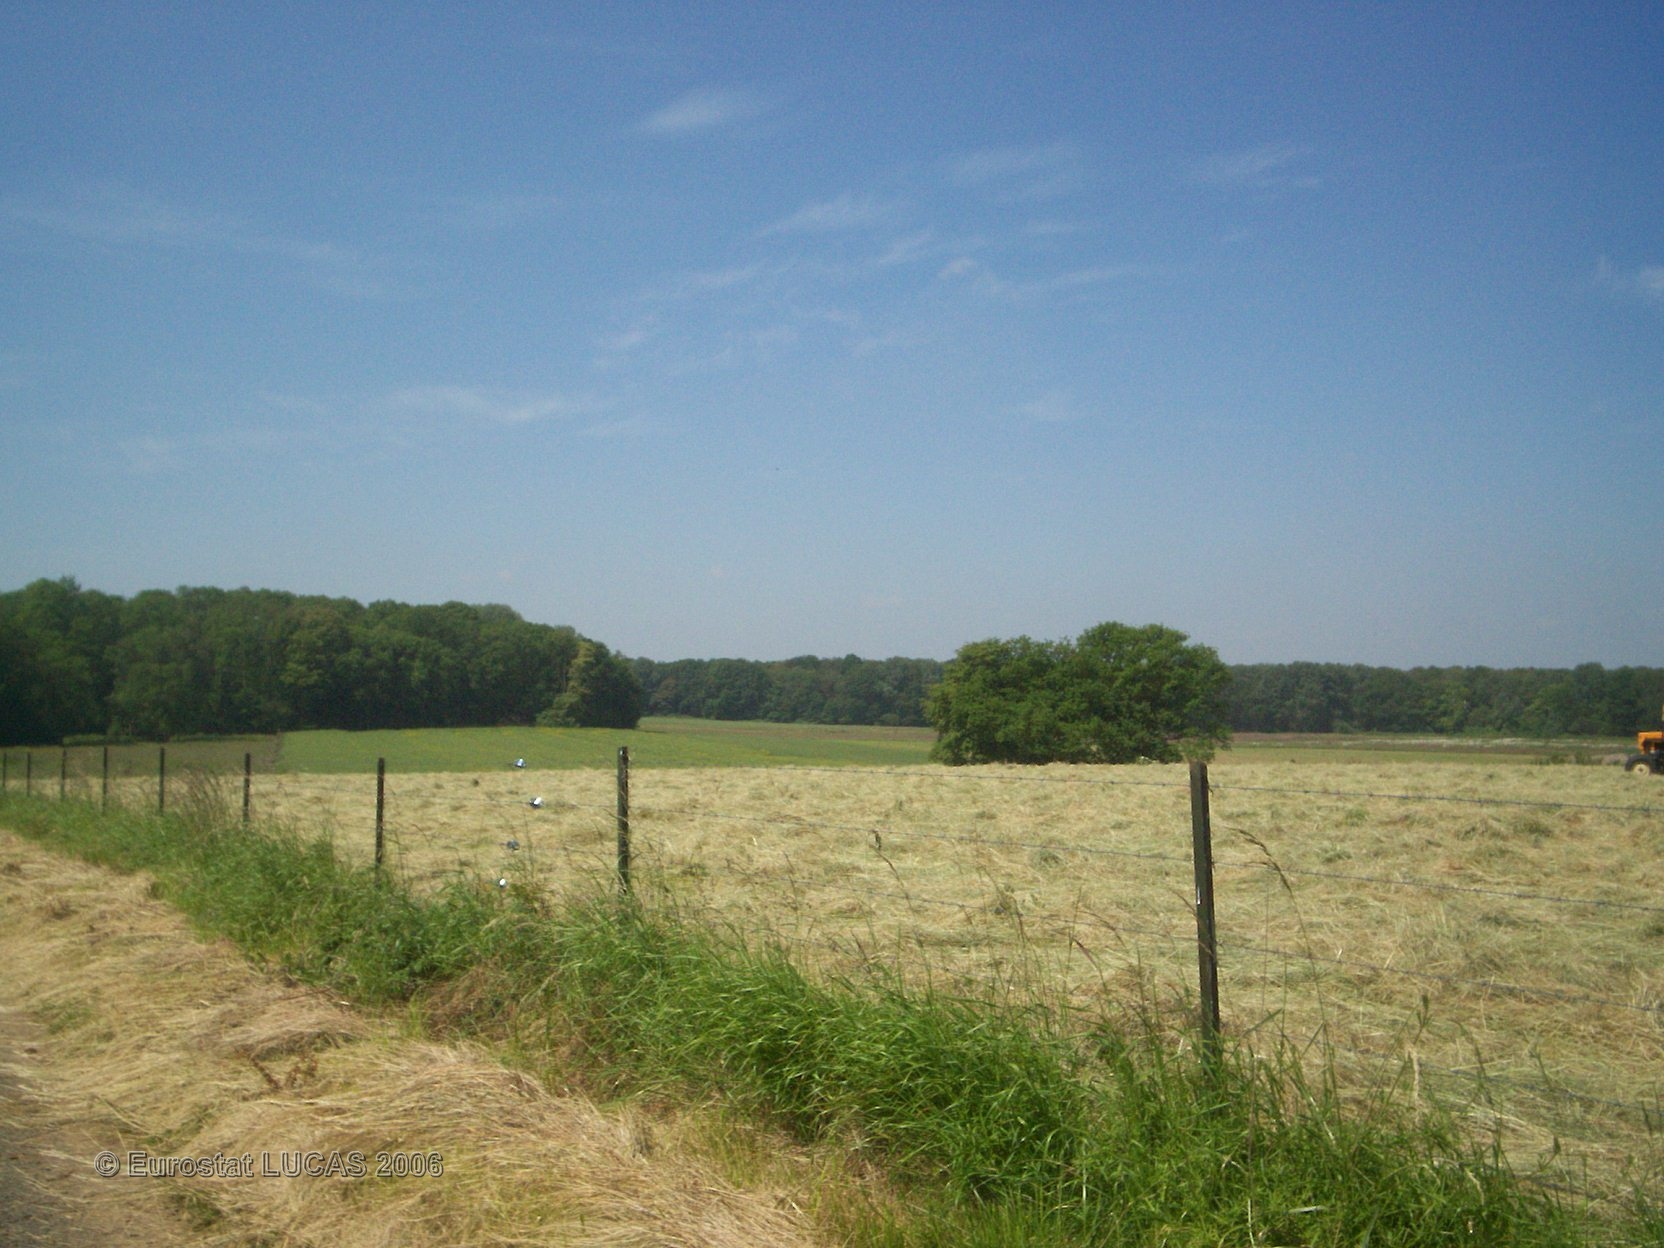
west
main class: Grassland
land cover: Grassland without tree/shrub cover
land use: Agriculture (excluding fallow land and kitchen gardens)
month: June
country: FR
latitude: 49.6247
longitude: 2.6935
